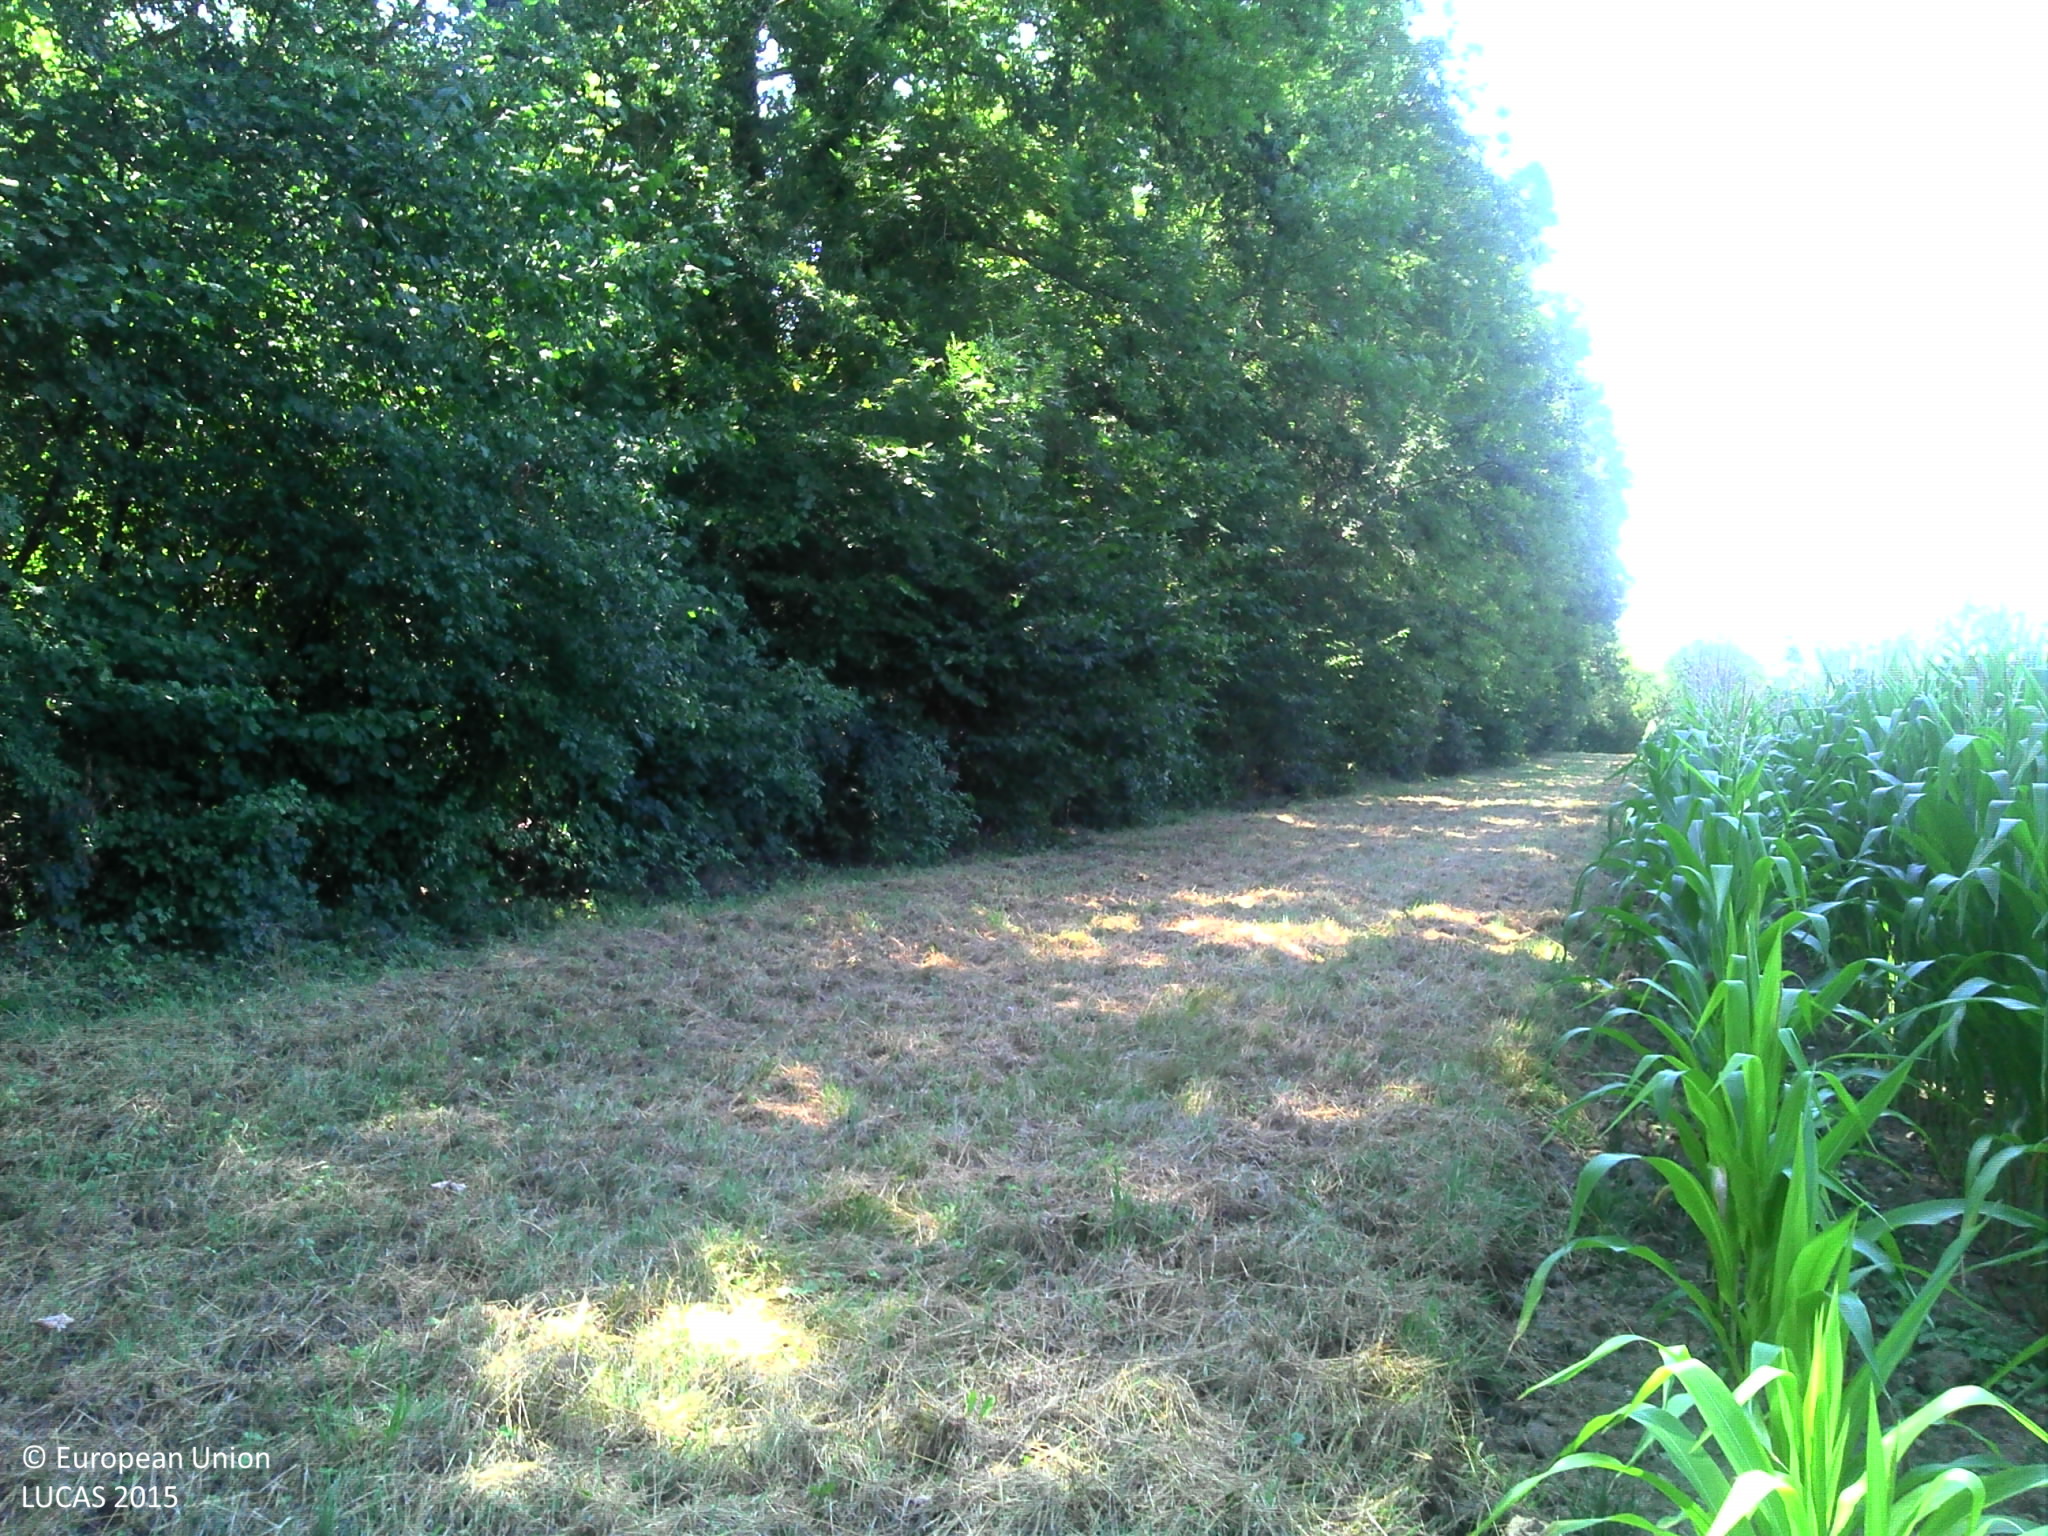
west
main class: Cropland
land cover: Maize
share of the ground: > 75 %
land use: Agriculture (excluding fallow land and kitchen gardens)
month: July
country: FR
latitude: 45.6410
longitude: 5.4498
